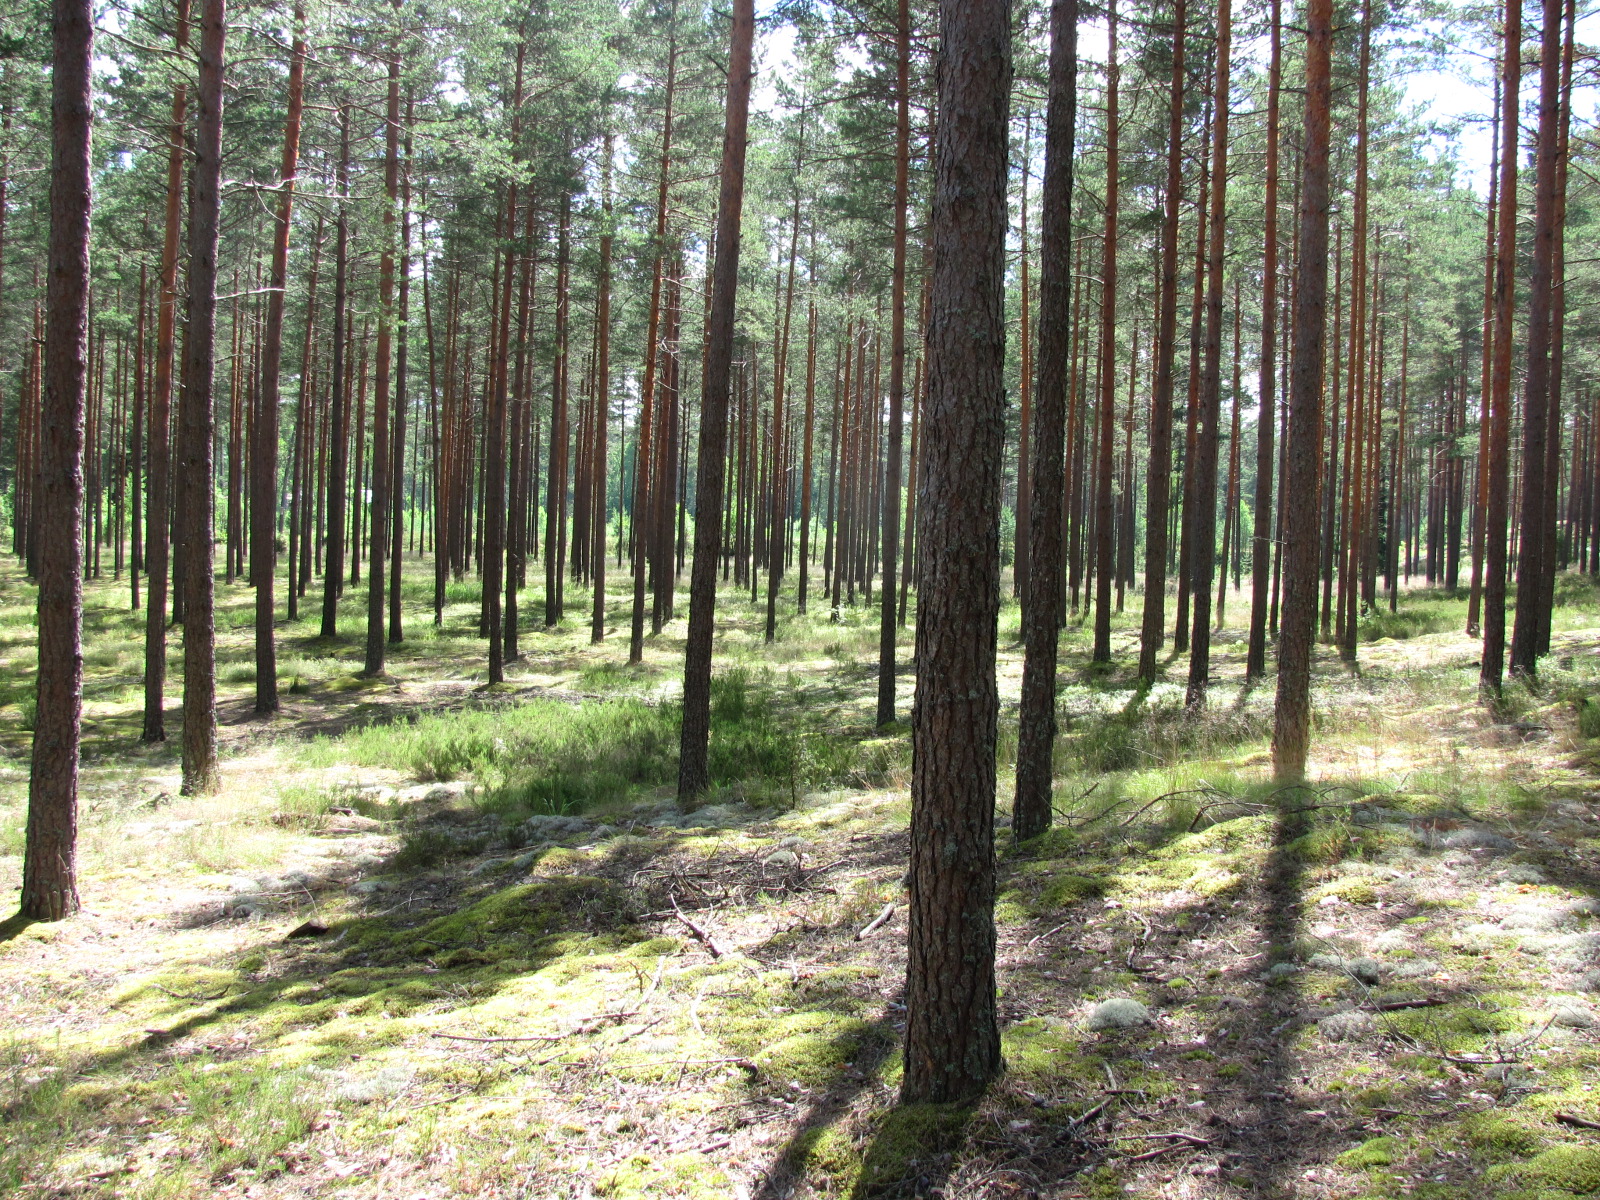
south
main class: Woodland
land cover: Pine dominated coniferous woodland
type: hemiboreal forest and nemoral coniferous forest and mixed broadleaved-coniferous forest
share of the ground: > 75 %
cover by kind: coniferous forest trees 80 %, lichens and mosses 15 %, shrubs 5 %
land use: Forestry
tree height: > 5 m
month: July
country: LV
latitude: 57.0201
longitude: 24.3715
